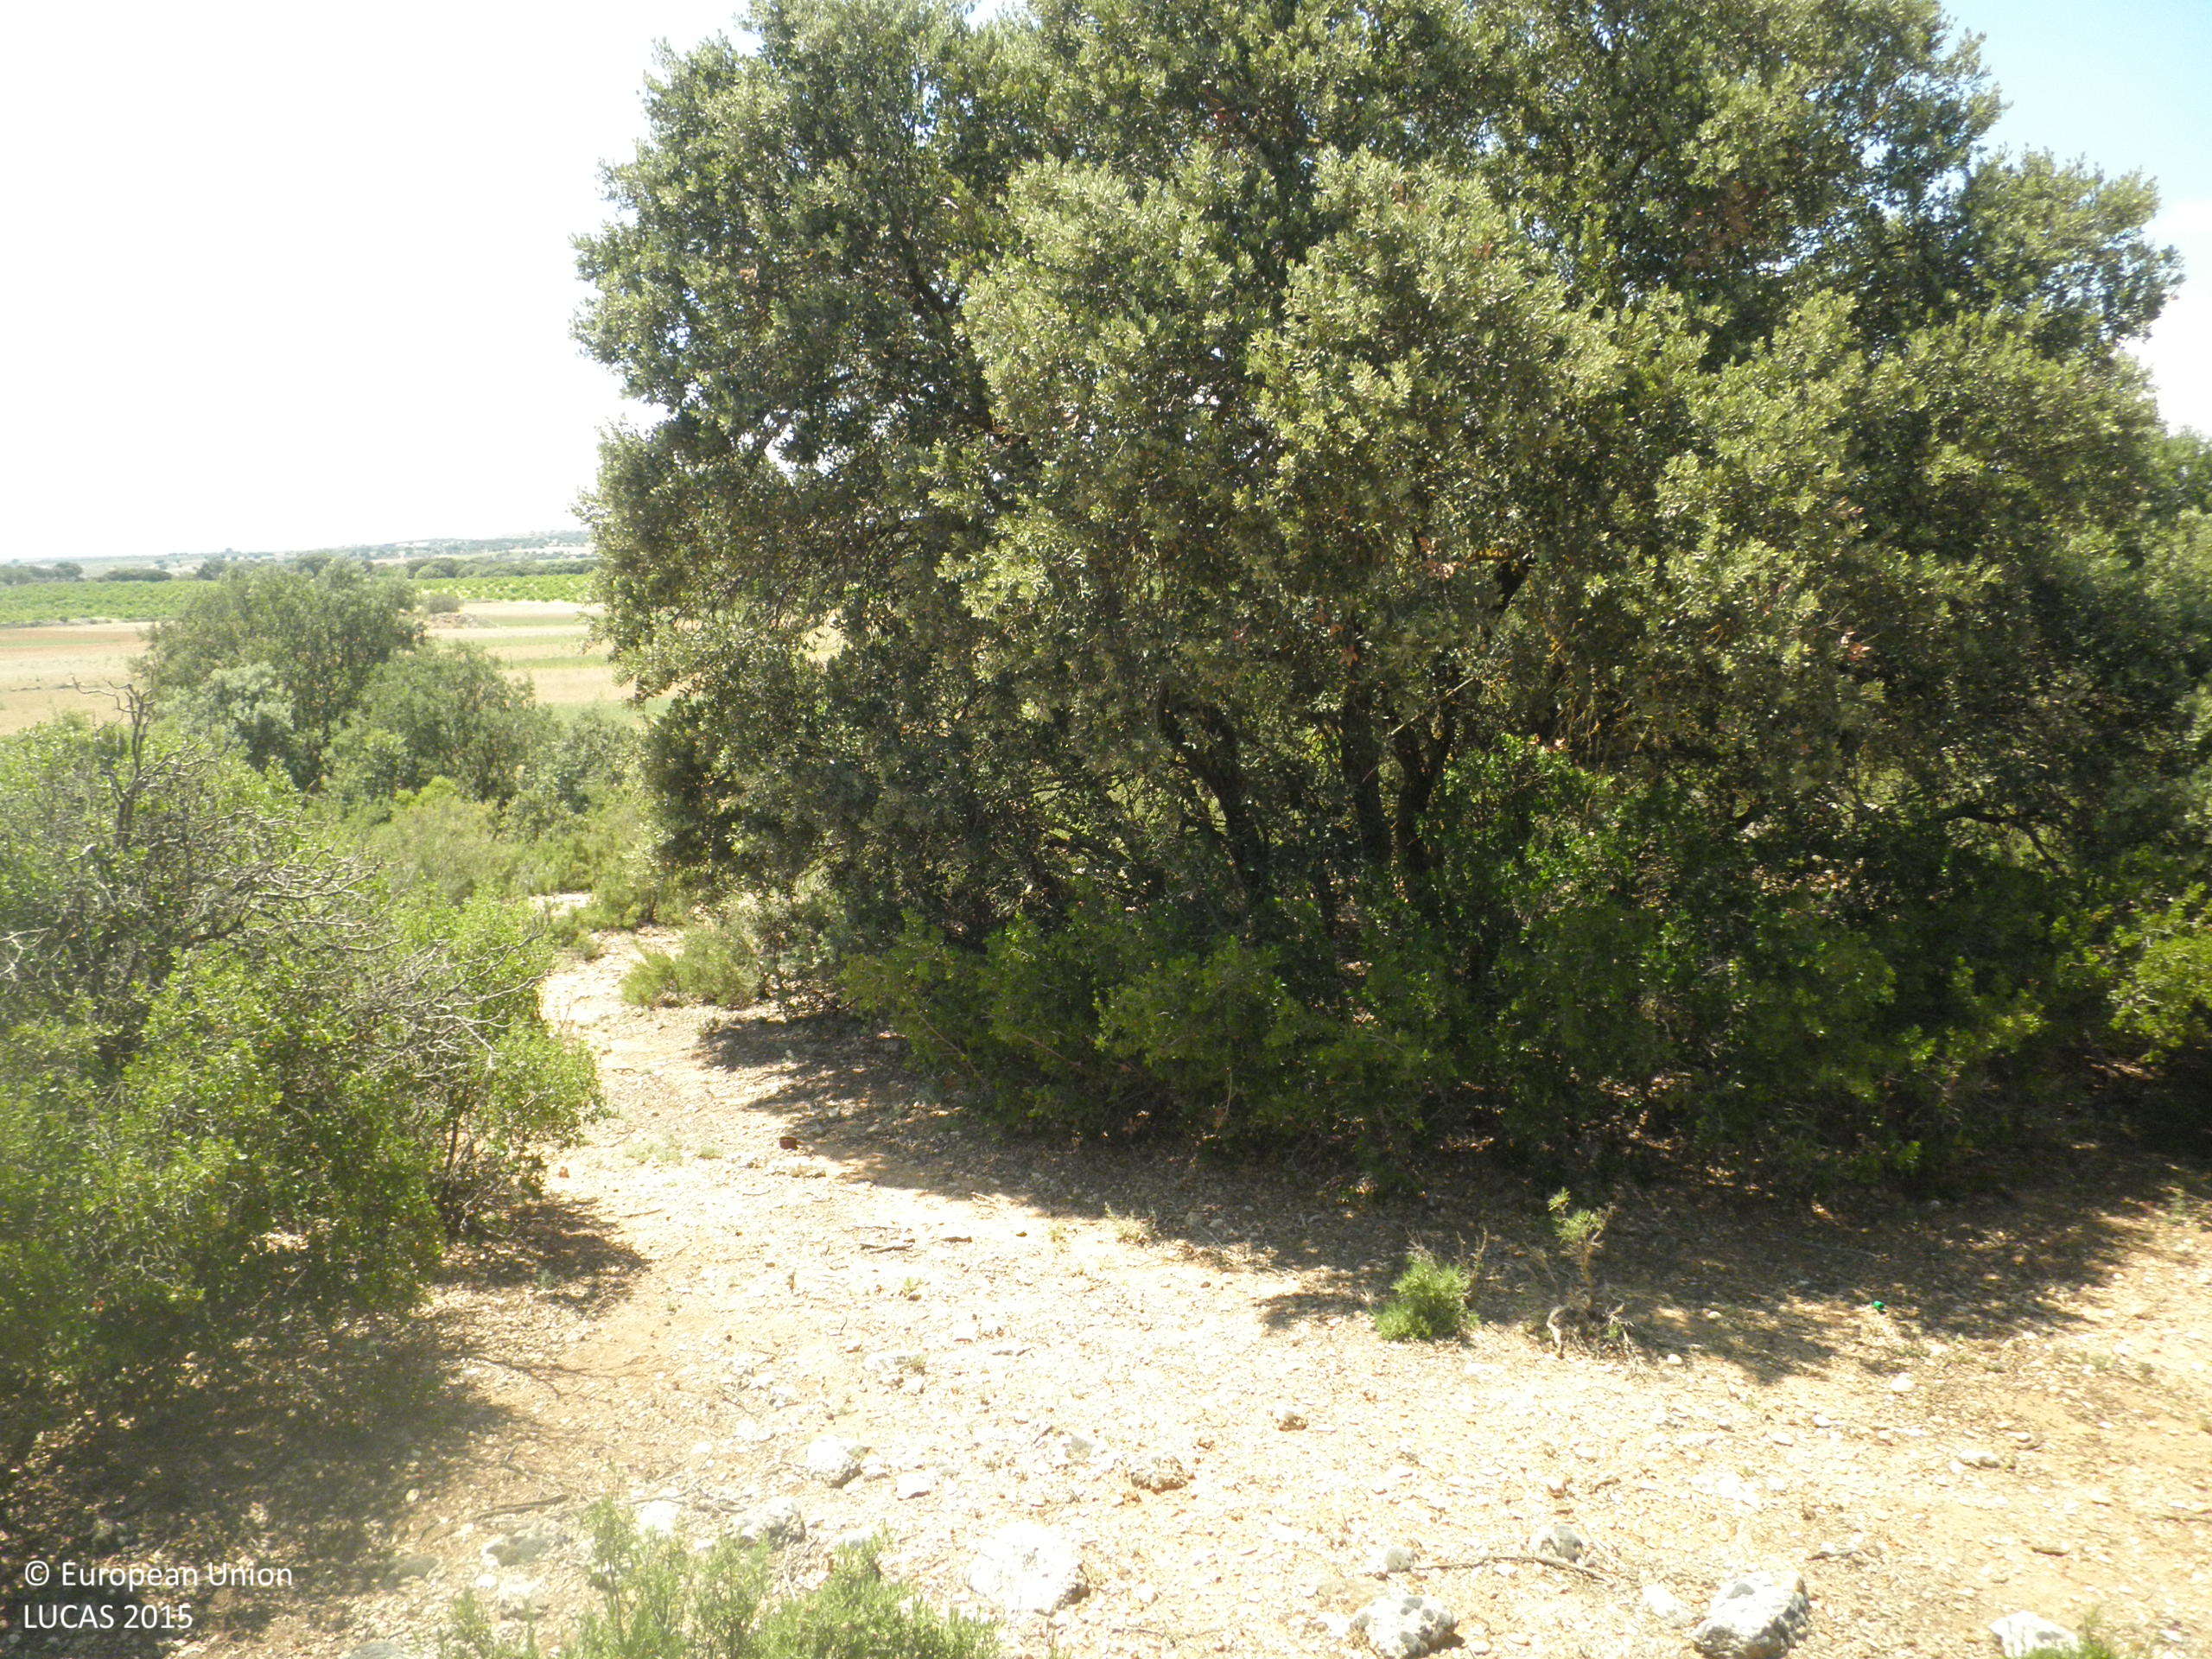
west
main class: Woodland
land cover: Broadleaved woodland
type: broadleaved evergreen forest
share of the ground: 25 - 50 %
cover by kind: unconsolidated bare surface 35 %, shrubs 30 %, broadleaved forest trees 25 %, consolidated bare surface 10 %
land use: Semi-natural and natural areas not in use
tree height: < 5 m
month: June
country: ES
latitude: 39.4900
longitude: -1.7141
